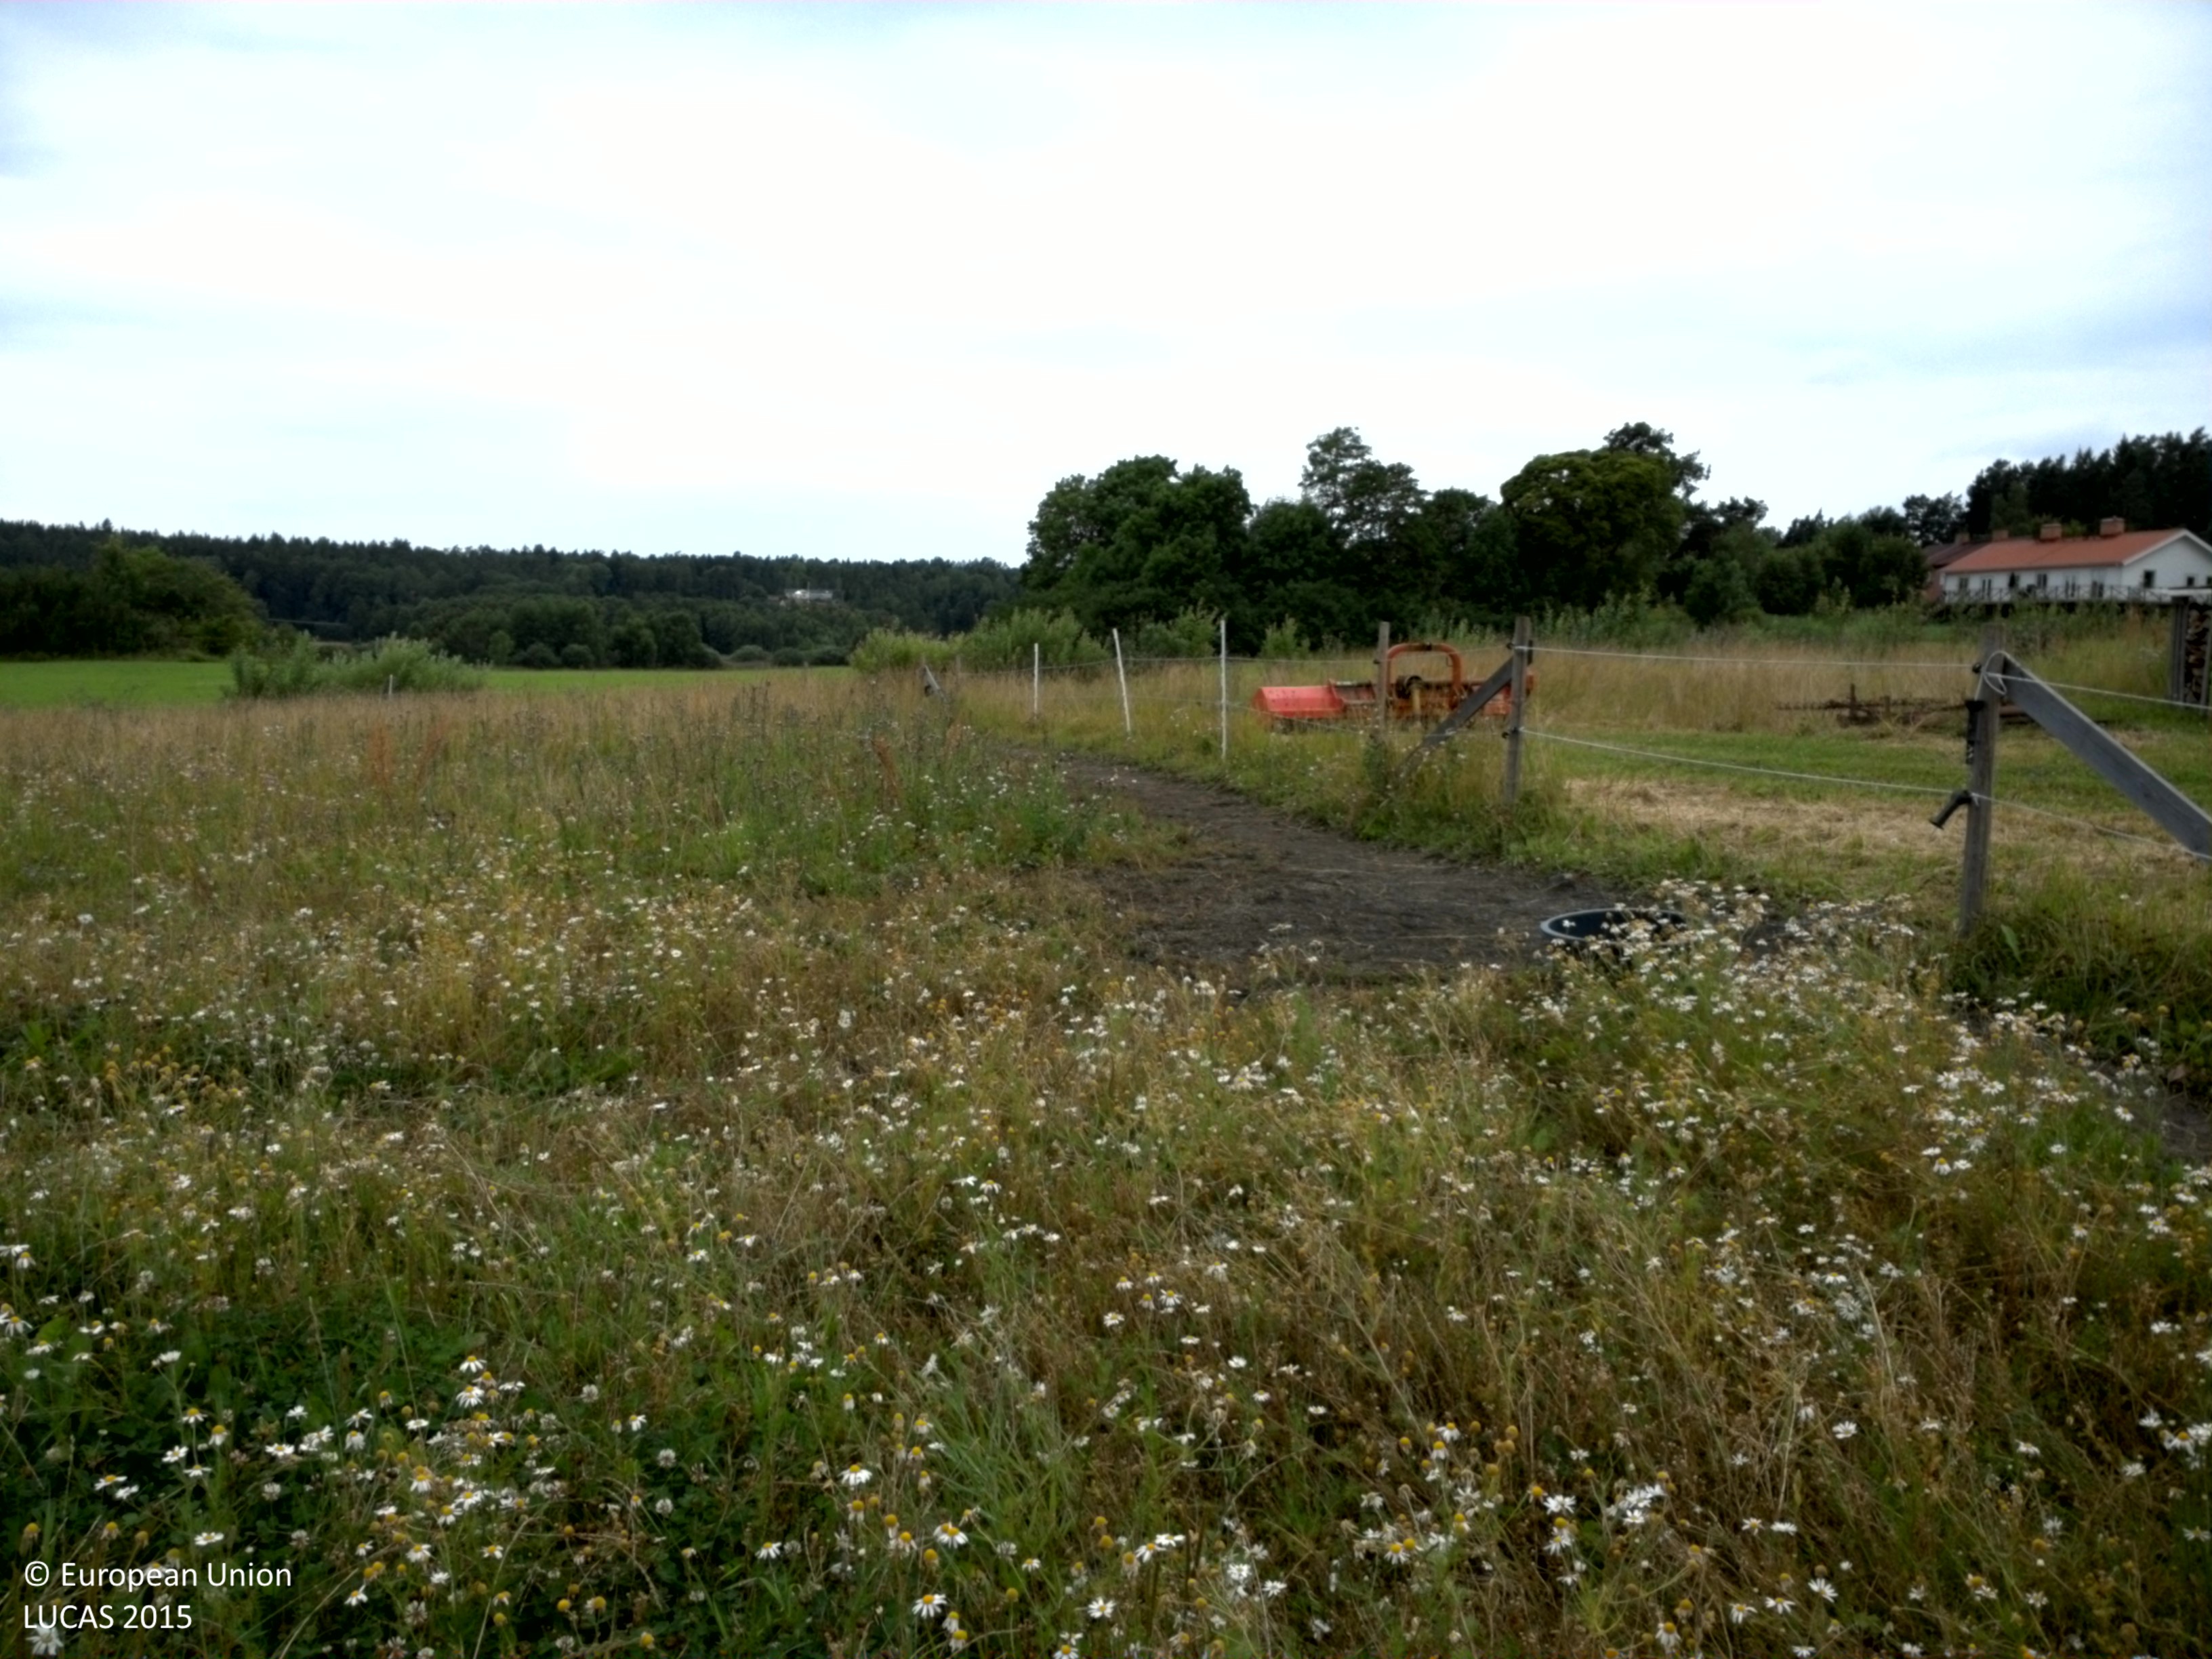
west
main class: Grassland
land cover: Grassland without tree/shrub cover
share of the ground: > 75 %
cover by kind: herbaceous plants 100 %
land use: Agriculture (excluding fallow land and kitchen gardens)
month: July
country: SE
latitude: 59.4665
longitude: 18.2754
